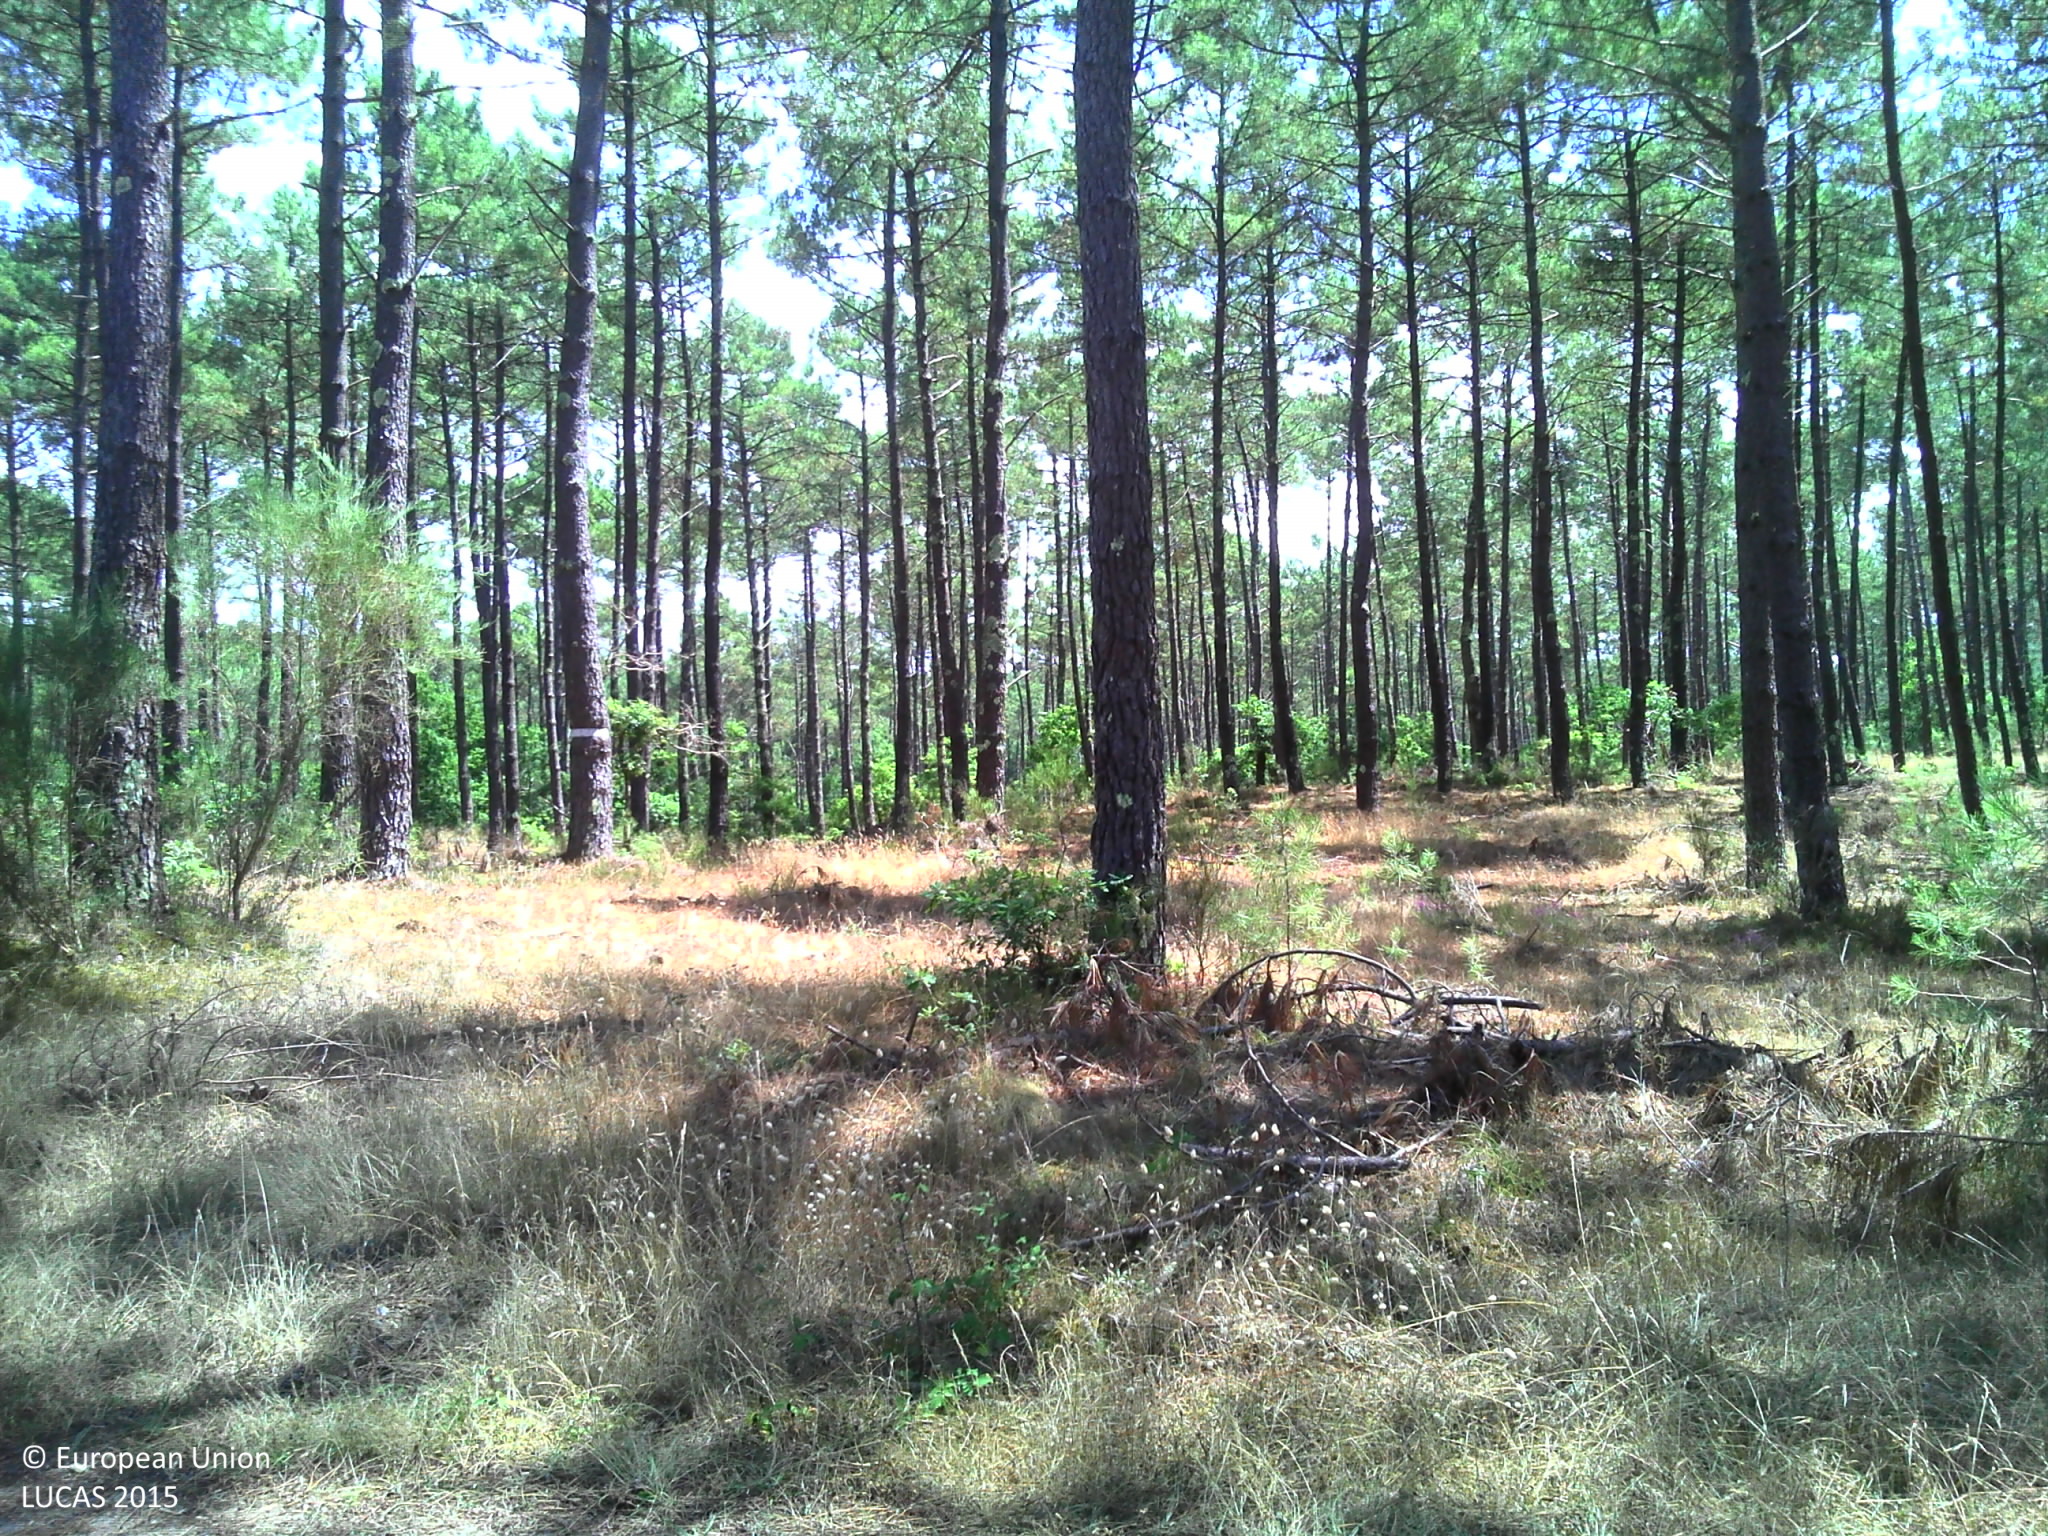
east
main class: Woodland
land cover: Pine dominated coniferous woodland
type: coniferous forest of the mediterranean region
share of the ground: > 75 %
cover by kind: coniferous forest trees 85 %, shrubs 10 %, herbaceous plants 5 %
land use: Forestry
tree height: > 5 m
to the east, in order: Pine dominated coniferous woodland; Tracks; Pine dominated coniferous woodland
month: July
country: FR
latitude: 44.1335
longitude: -1.2825
